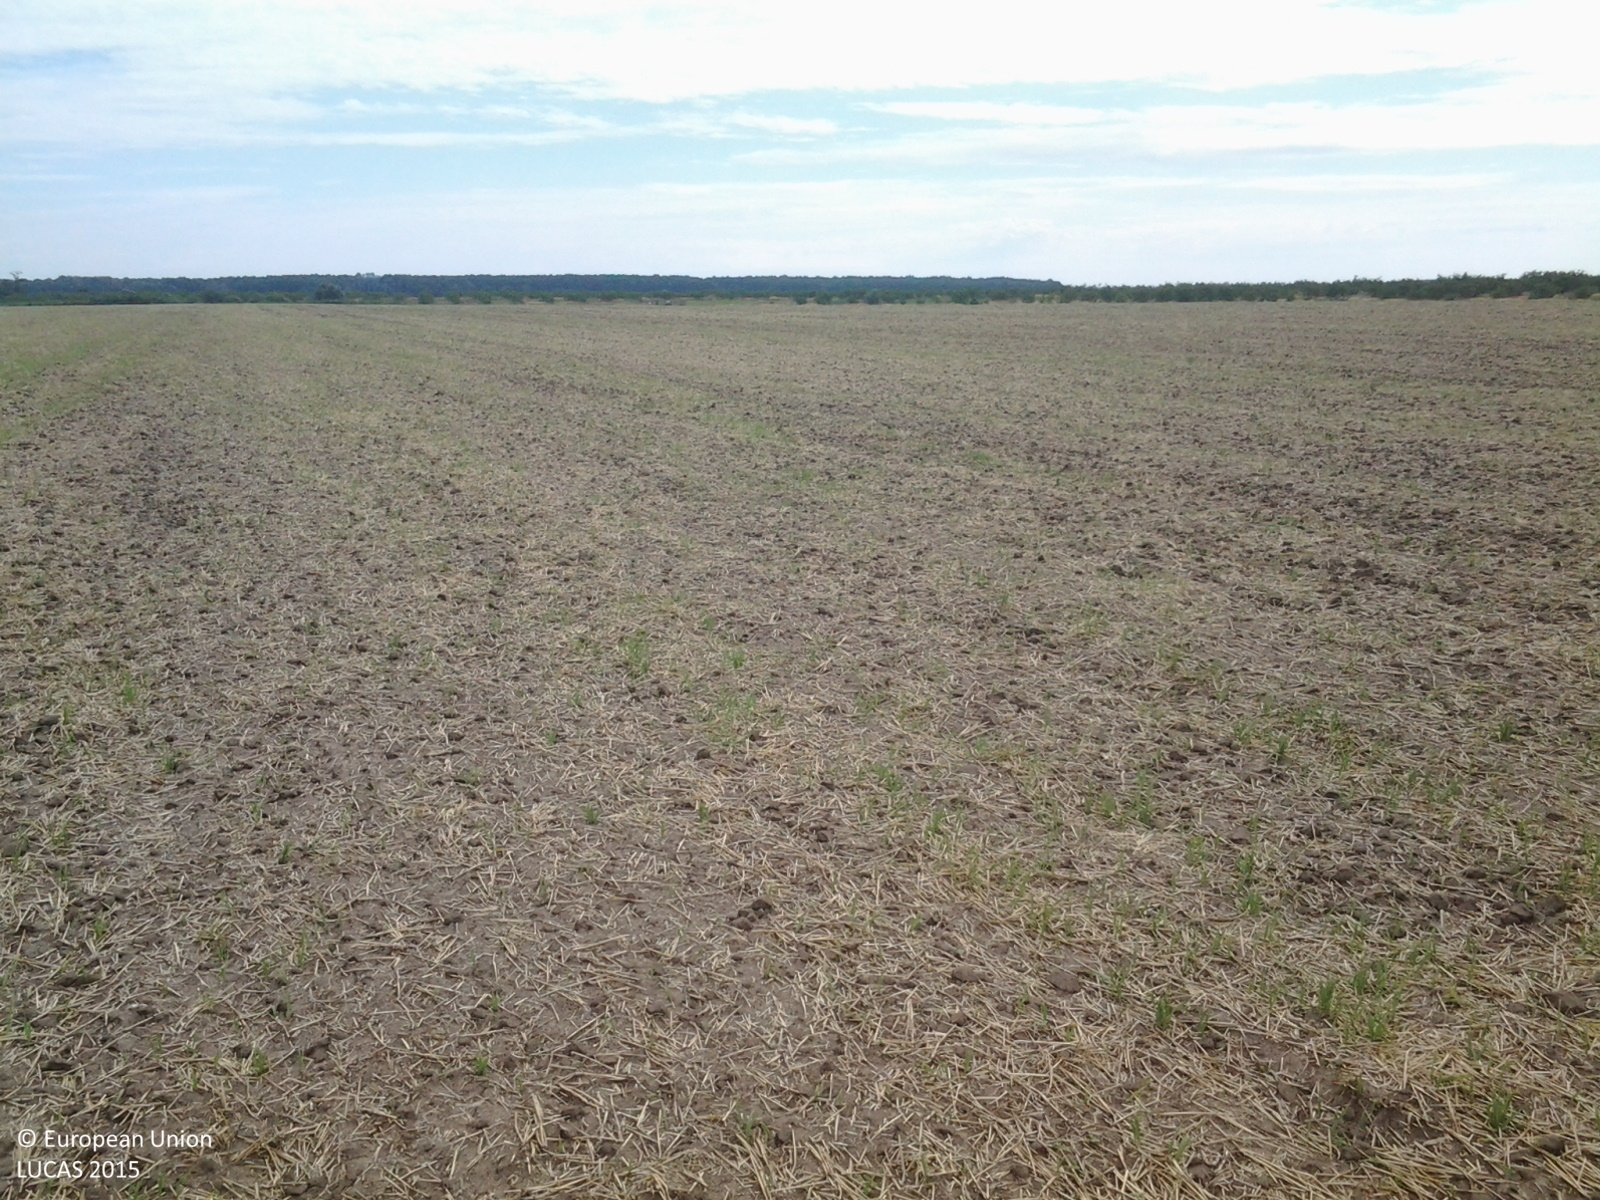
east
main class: Cropland
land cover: Common wheat
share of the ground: < 10 %
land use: Agriculture (excluding fallow land and kitchen gardens)
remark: Harvested field
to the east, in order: Common wheat
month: July
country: HU
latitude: 47.1006
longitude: 21.2504
